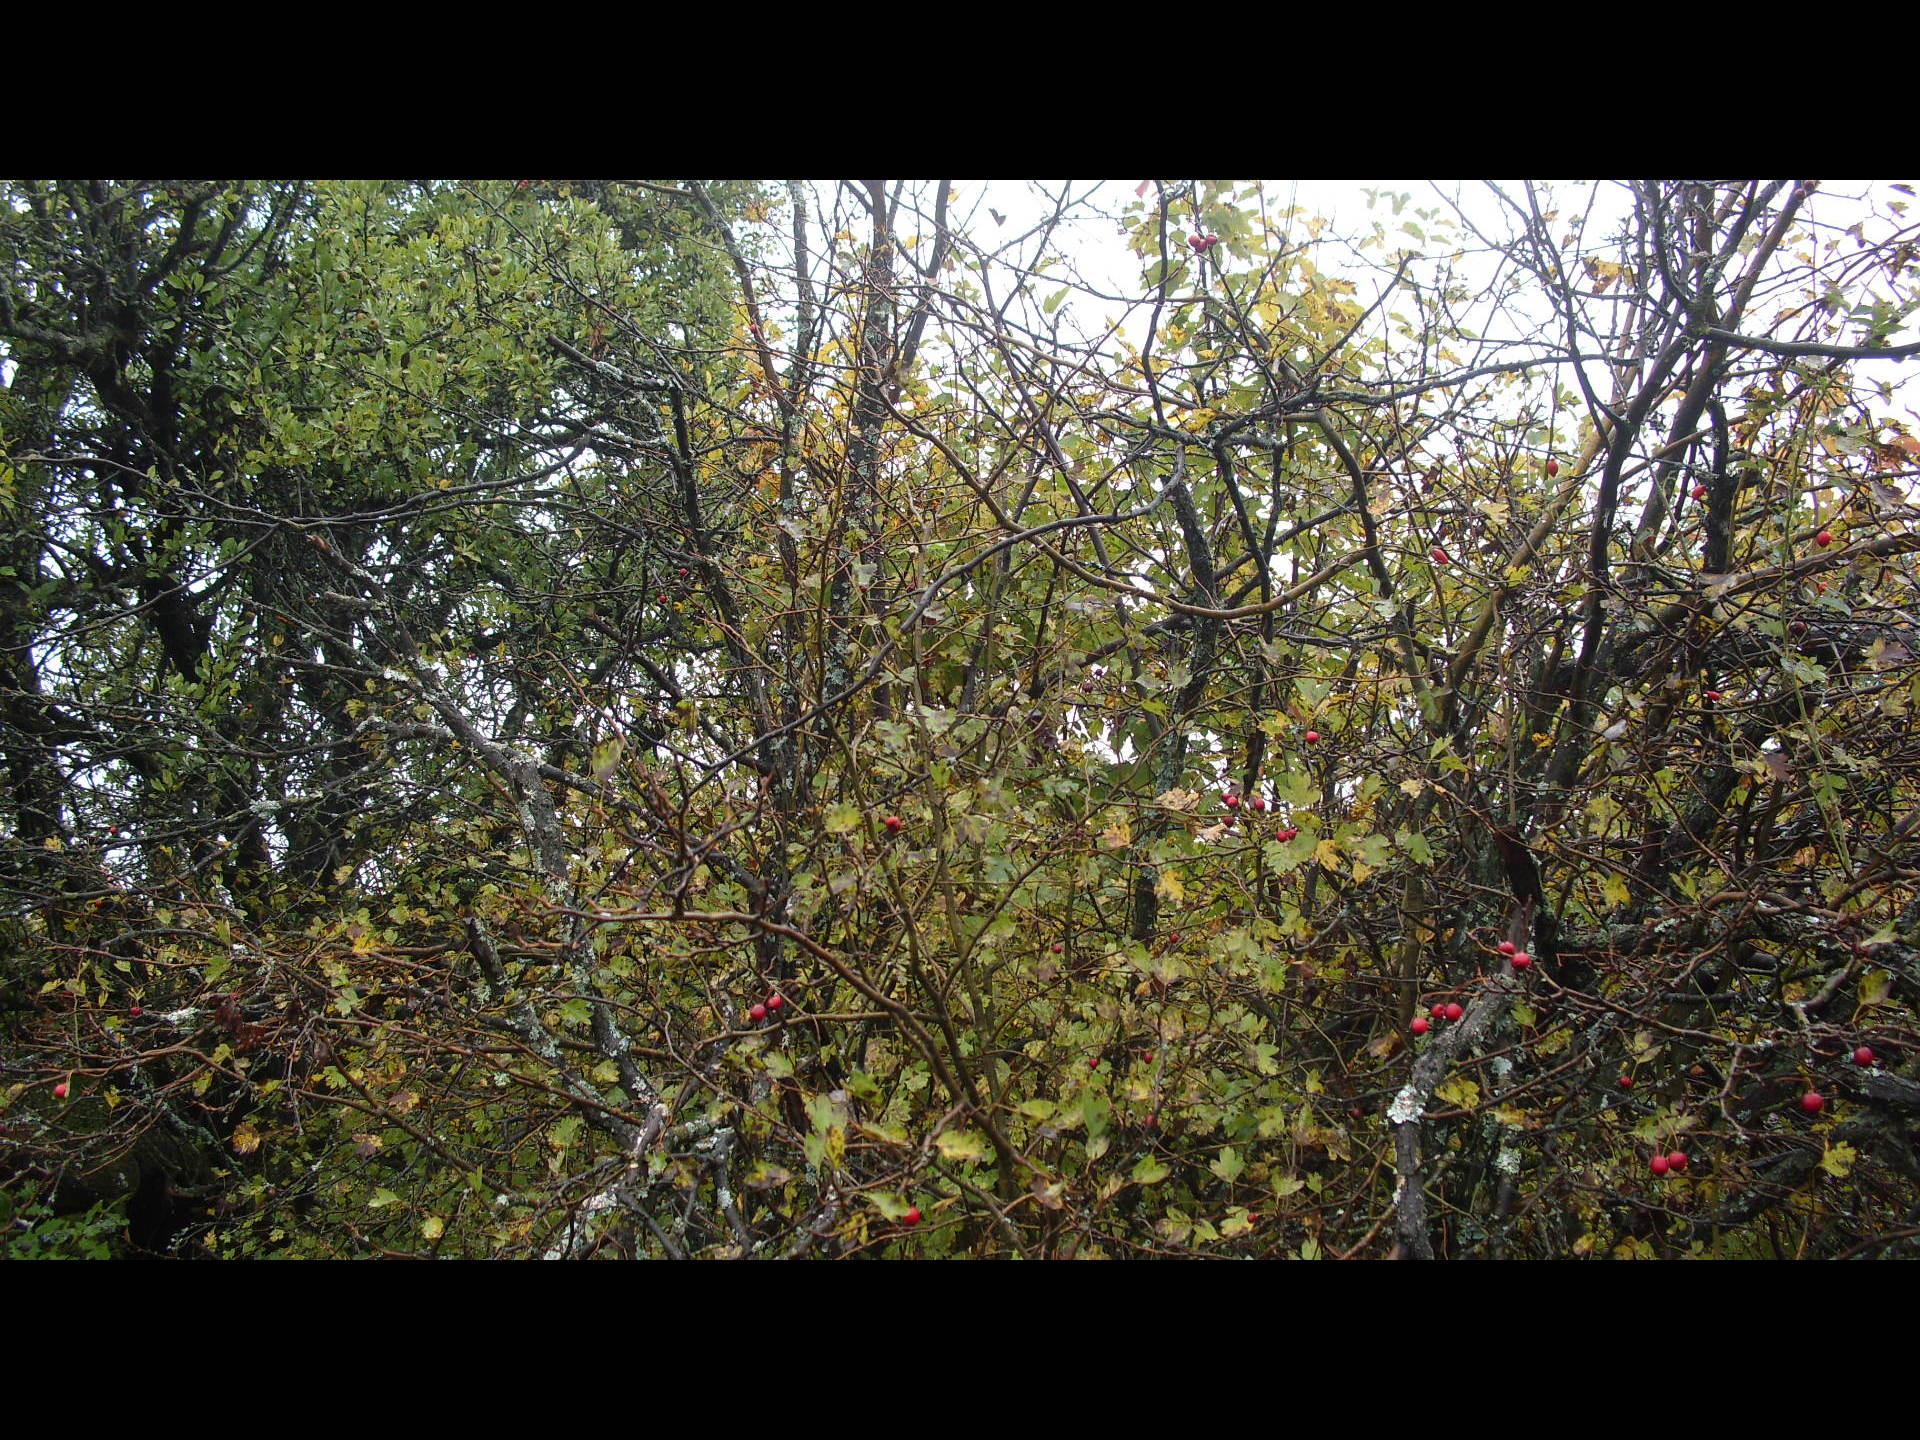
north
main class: Shrubland
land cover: Shrubland with sparse tree cover
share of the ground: > 75 %
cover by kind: shrubs 95 %, broadleaved forest trees 5 %
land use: Semi-natural and natural areas not in use
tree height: < 5 m
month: October
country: BG
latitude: 43.7300
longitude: 22.5595
